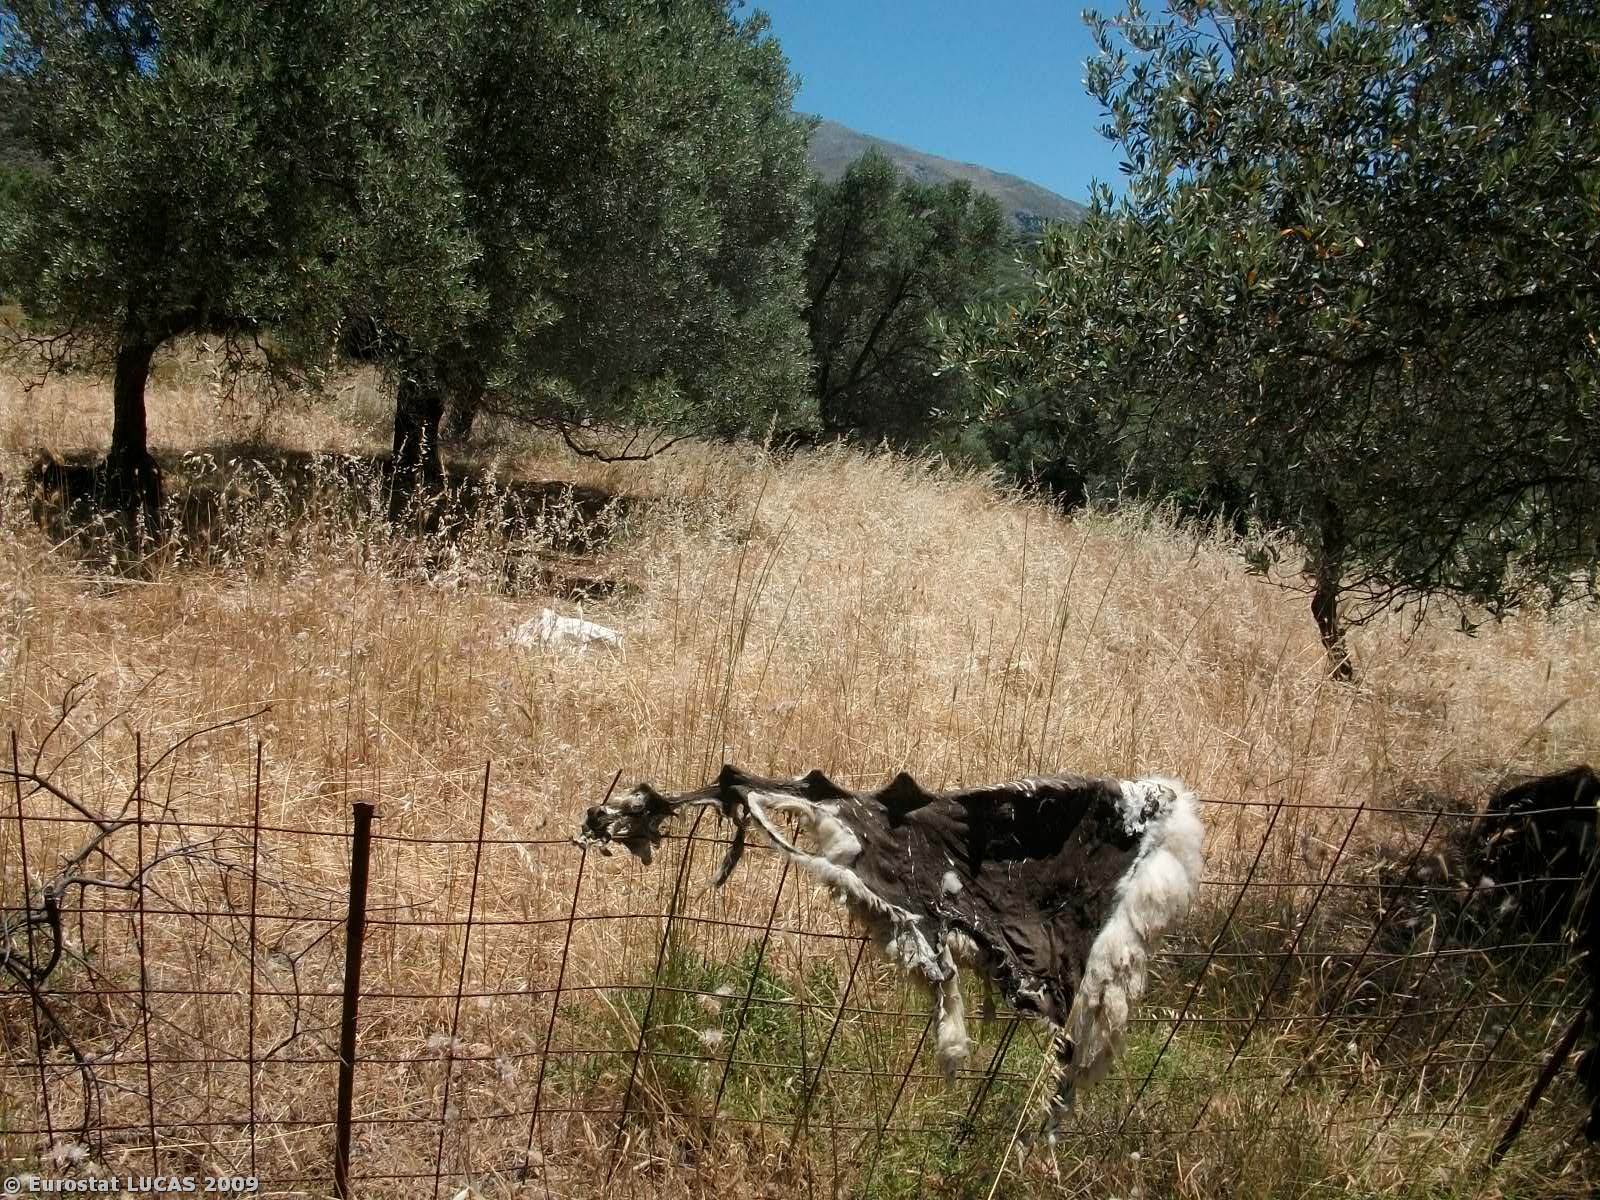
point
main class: Cropland
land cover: Olive groves
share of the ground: 25 - 50 %
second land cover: Grassland with sparse tree/shrub cover
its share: 50 - 75 %
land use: Agriculture (excluding fallow land and kitchen gardens)
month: June
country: GR
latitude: 35.2274
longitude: 24.5210
